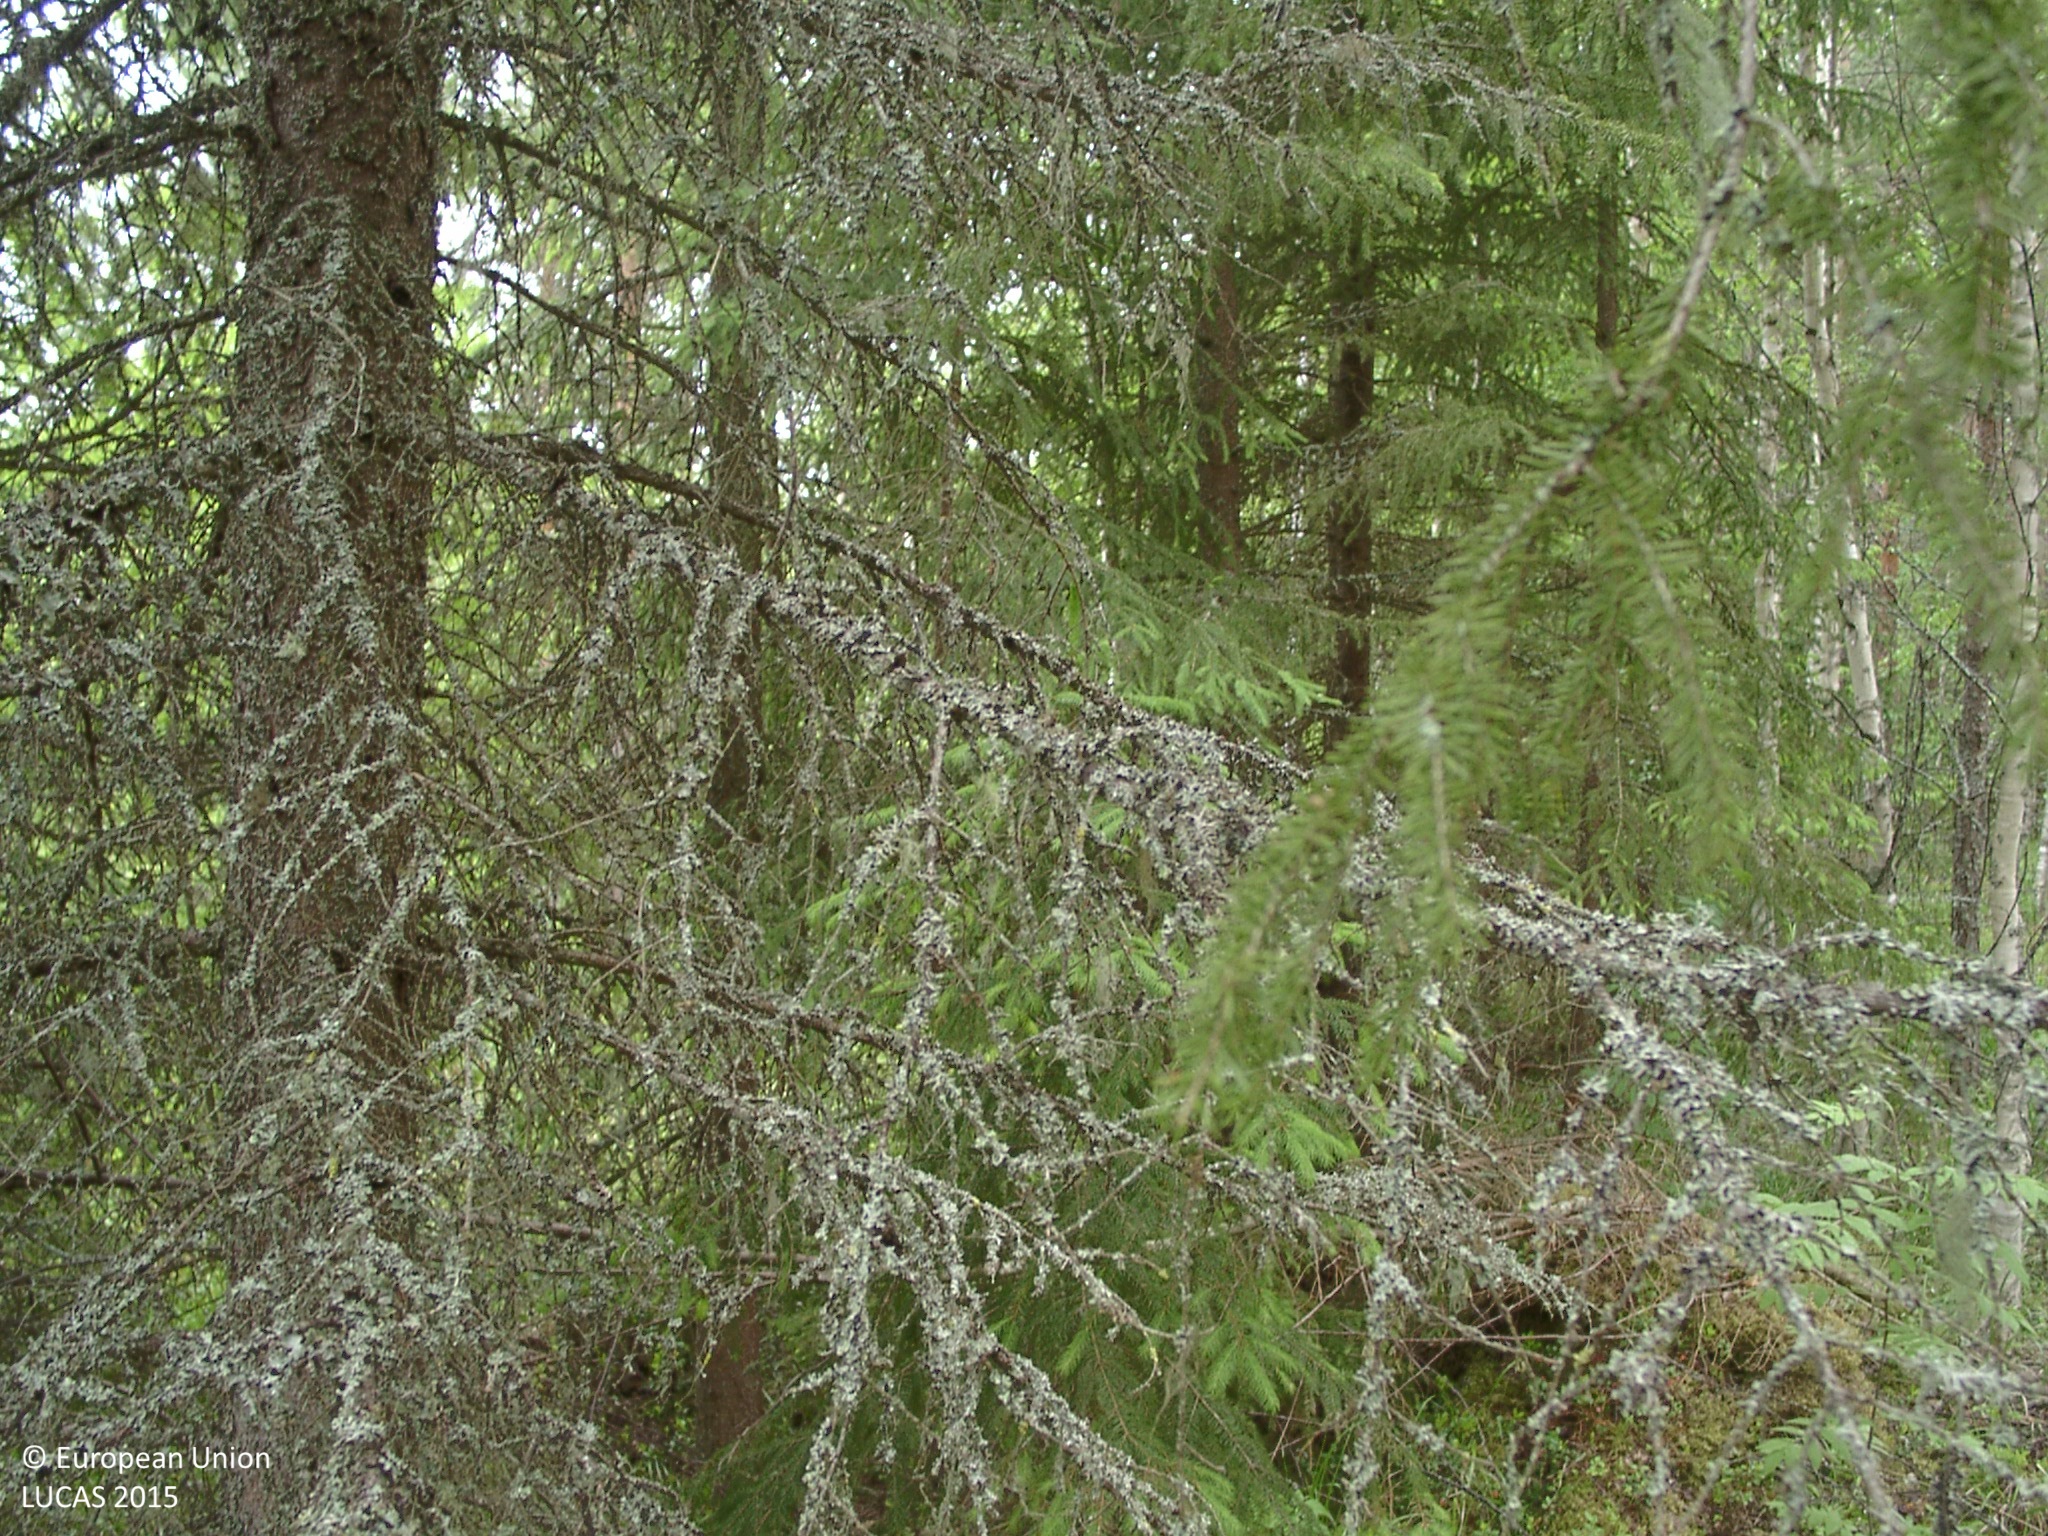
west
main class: Woodland
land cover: Spruce dominated mixed woodland
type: boreal forest
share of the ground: 50 - 75 %
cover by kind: coniferous forest trees 40 %, broadleaved forest trees 25 %, shrubs 20 %, herbaceous plants 10 %, lichens and mosses 5 %
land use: Semi-natural and natural areas not in use
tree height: > 5 m
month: June
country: FI
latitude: 61.6819
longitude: 24.7089
